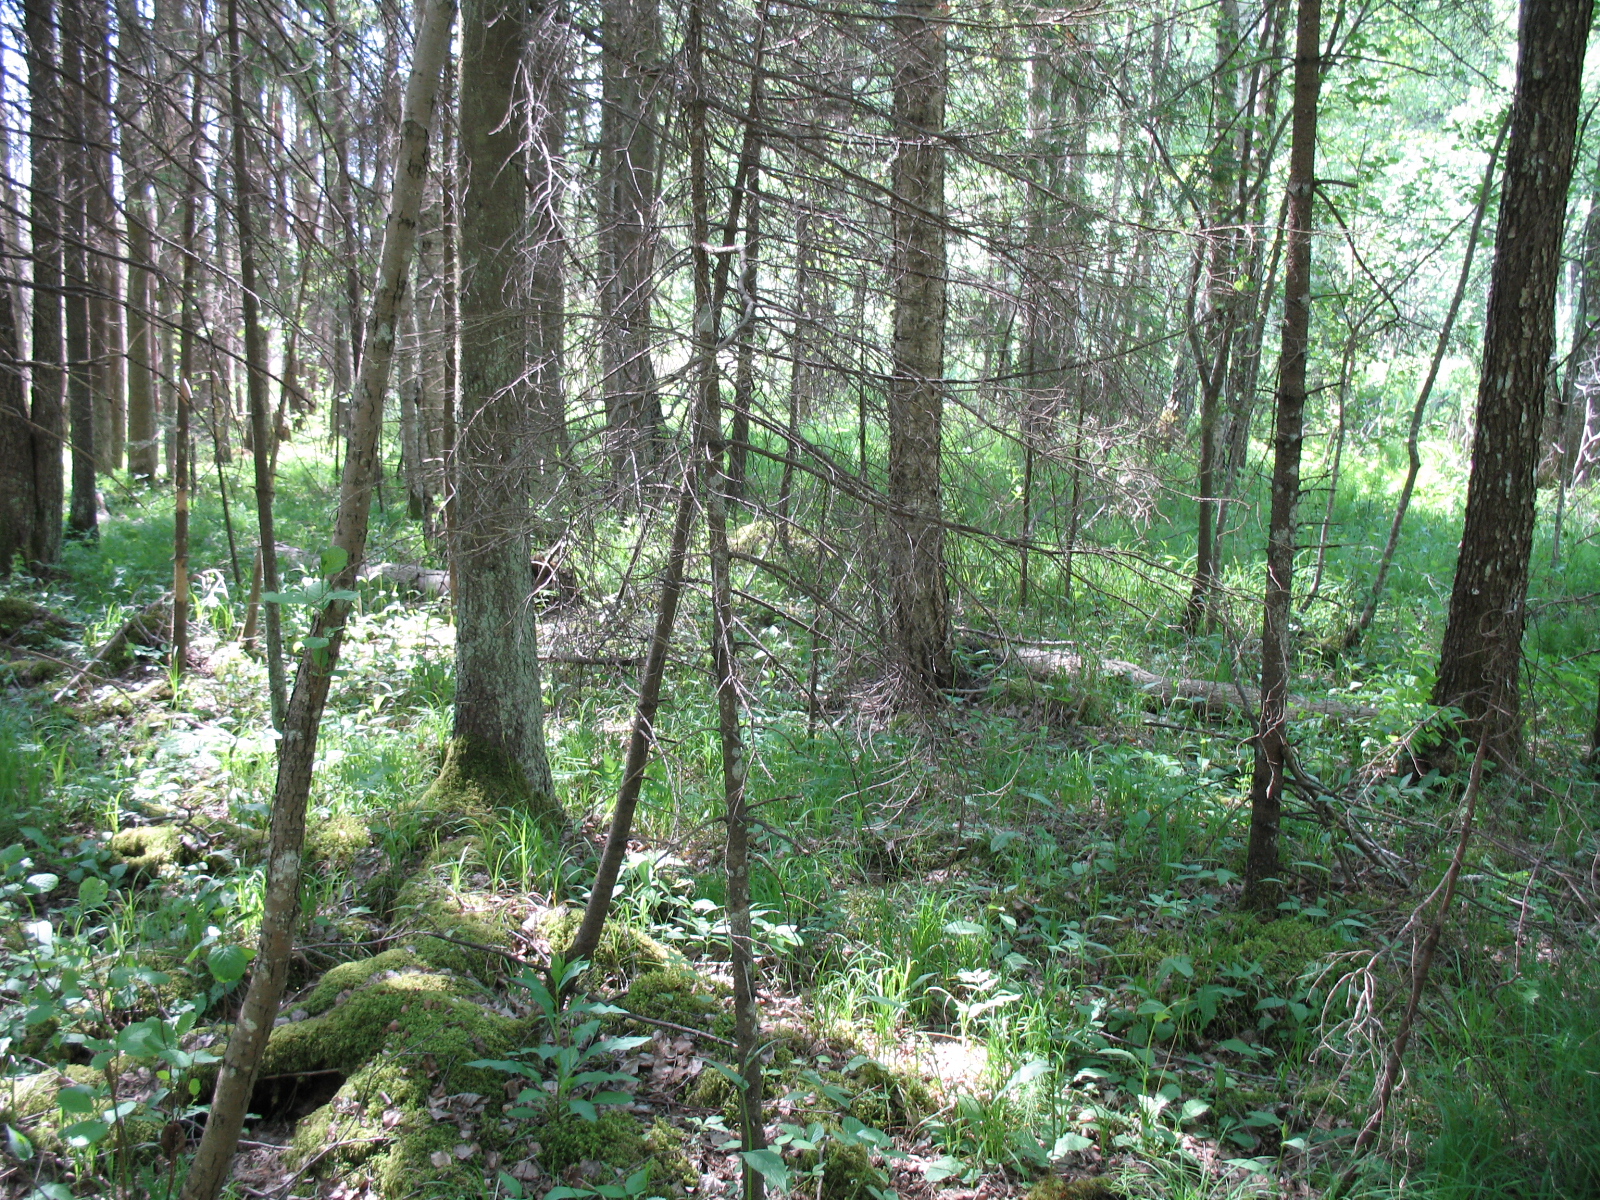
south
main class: Woodland
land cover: Spruce dominated mixed woodland
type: mire and swamp forests
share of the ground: > 75 %
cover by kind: broadleaved forest trees 50 %, coniferous forest trees 45 %, herbaceous plants 5 %
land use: Forestry
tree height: > 5 m
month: May
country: LV
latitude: 56.8541
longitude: 23.5374
